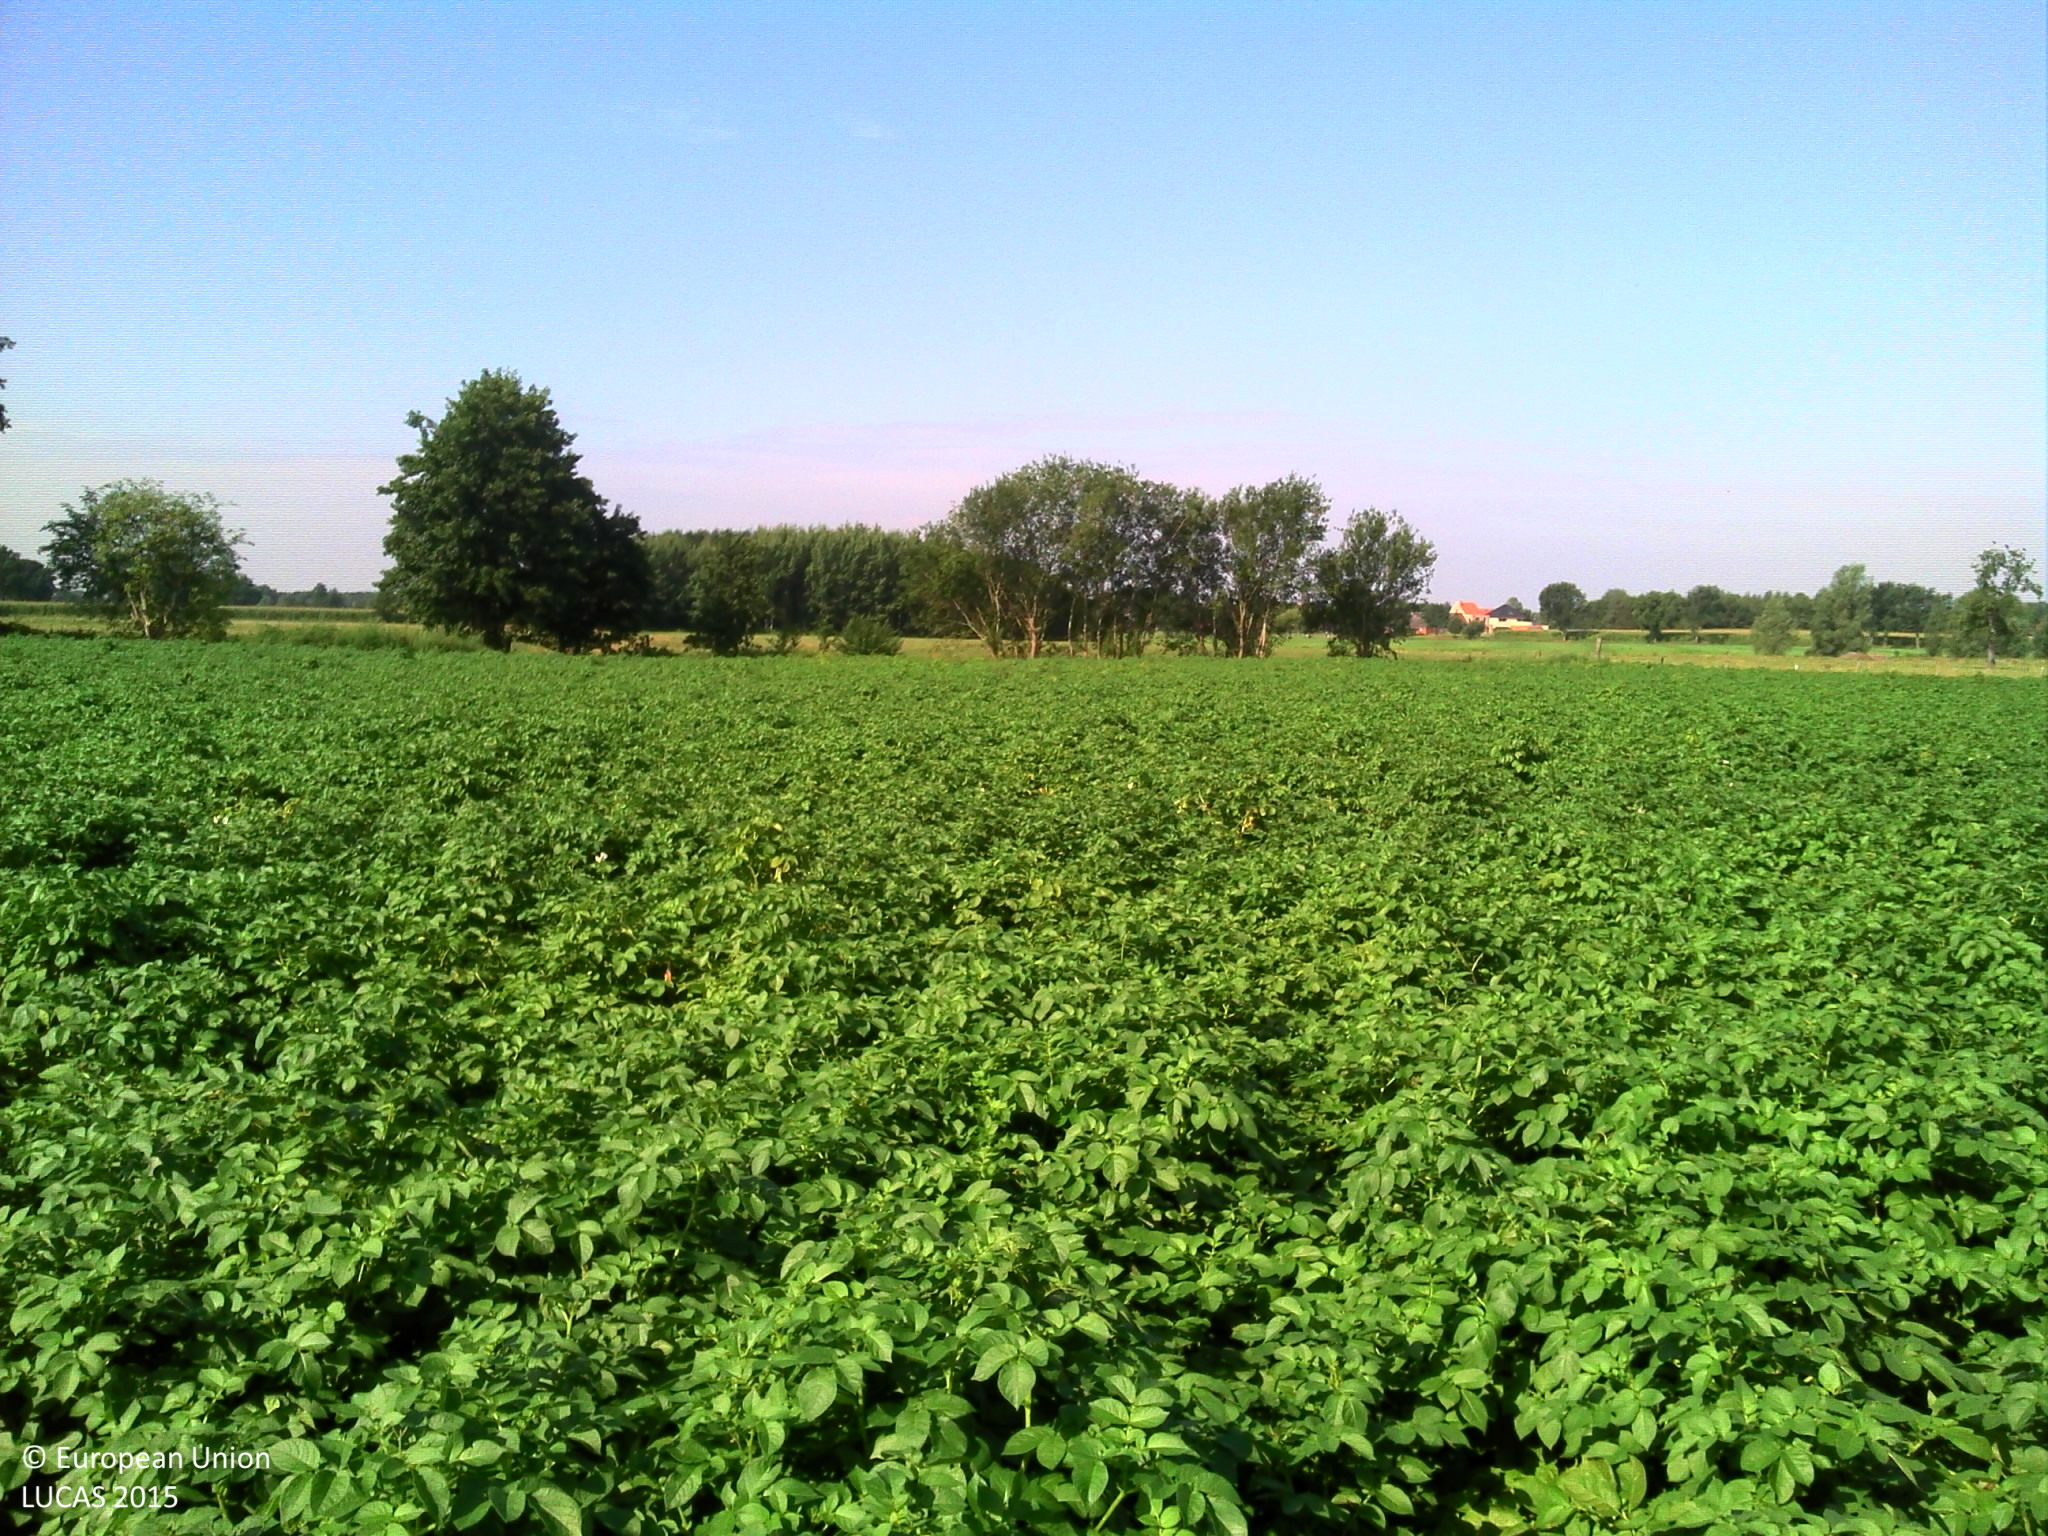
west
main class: Cropland
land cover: Potatoes
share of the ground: > 75 %
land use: Agriculture (excluding fallow land and kitchen gardens)
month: August
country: BE
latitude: 51.2682
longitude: 5.1099
